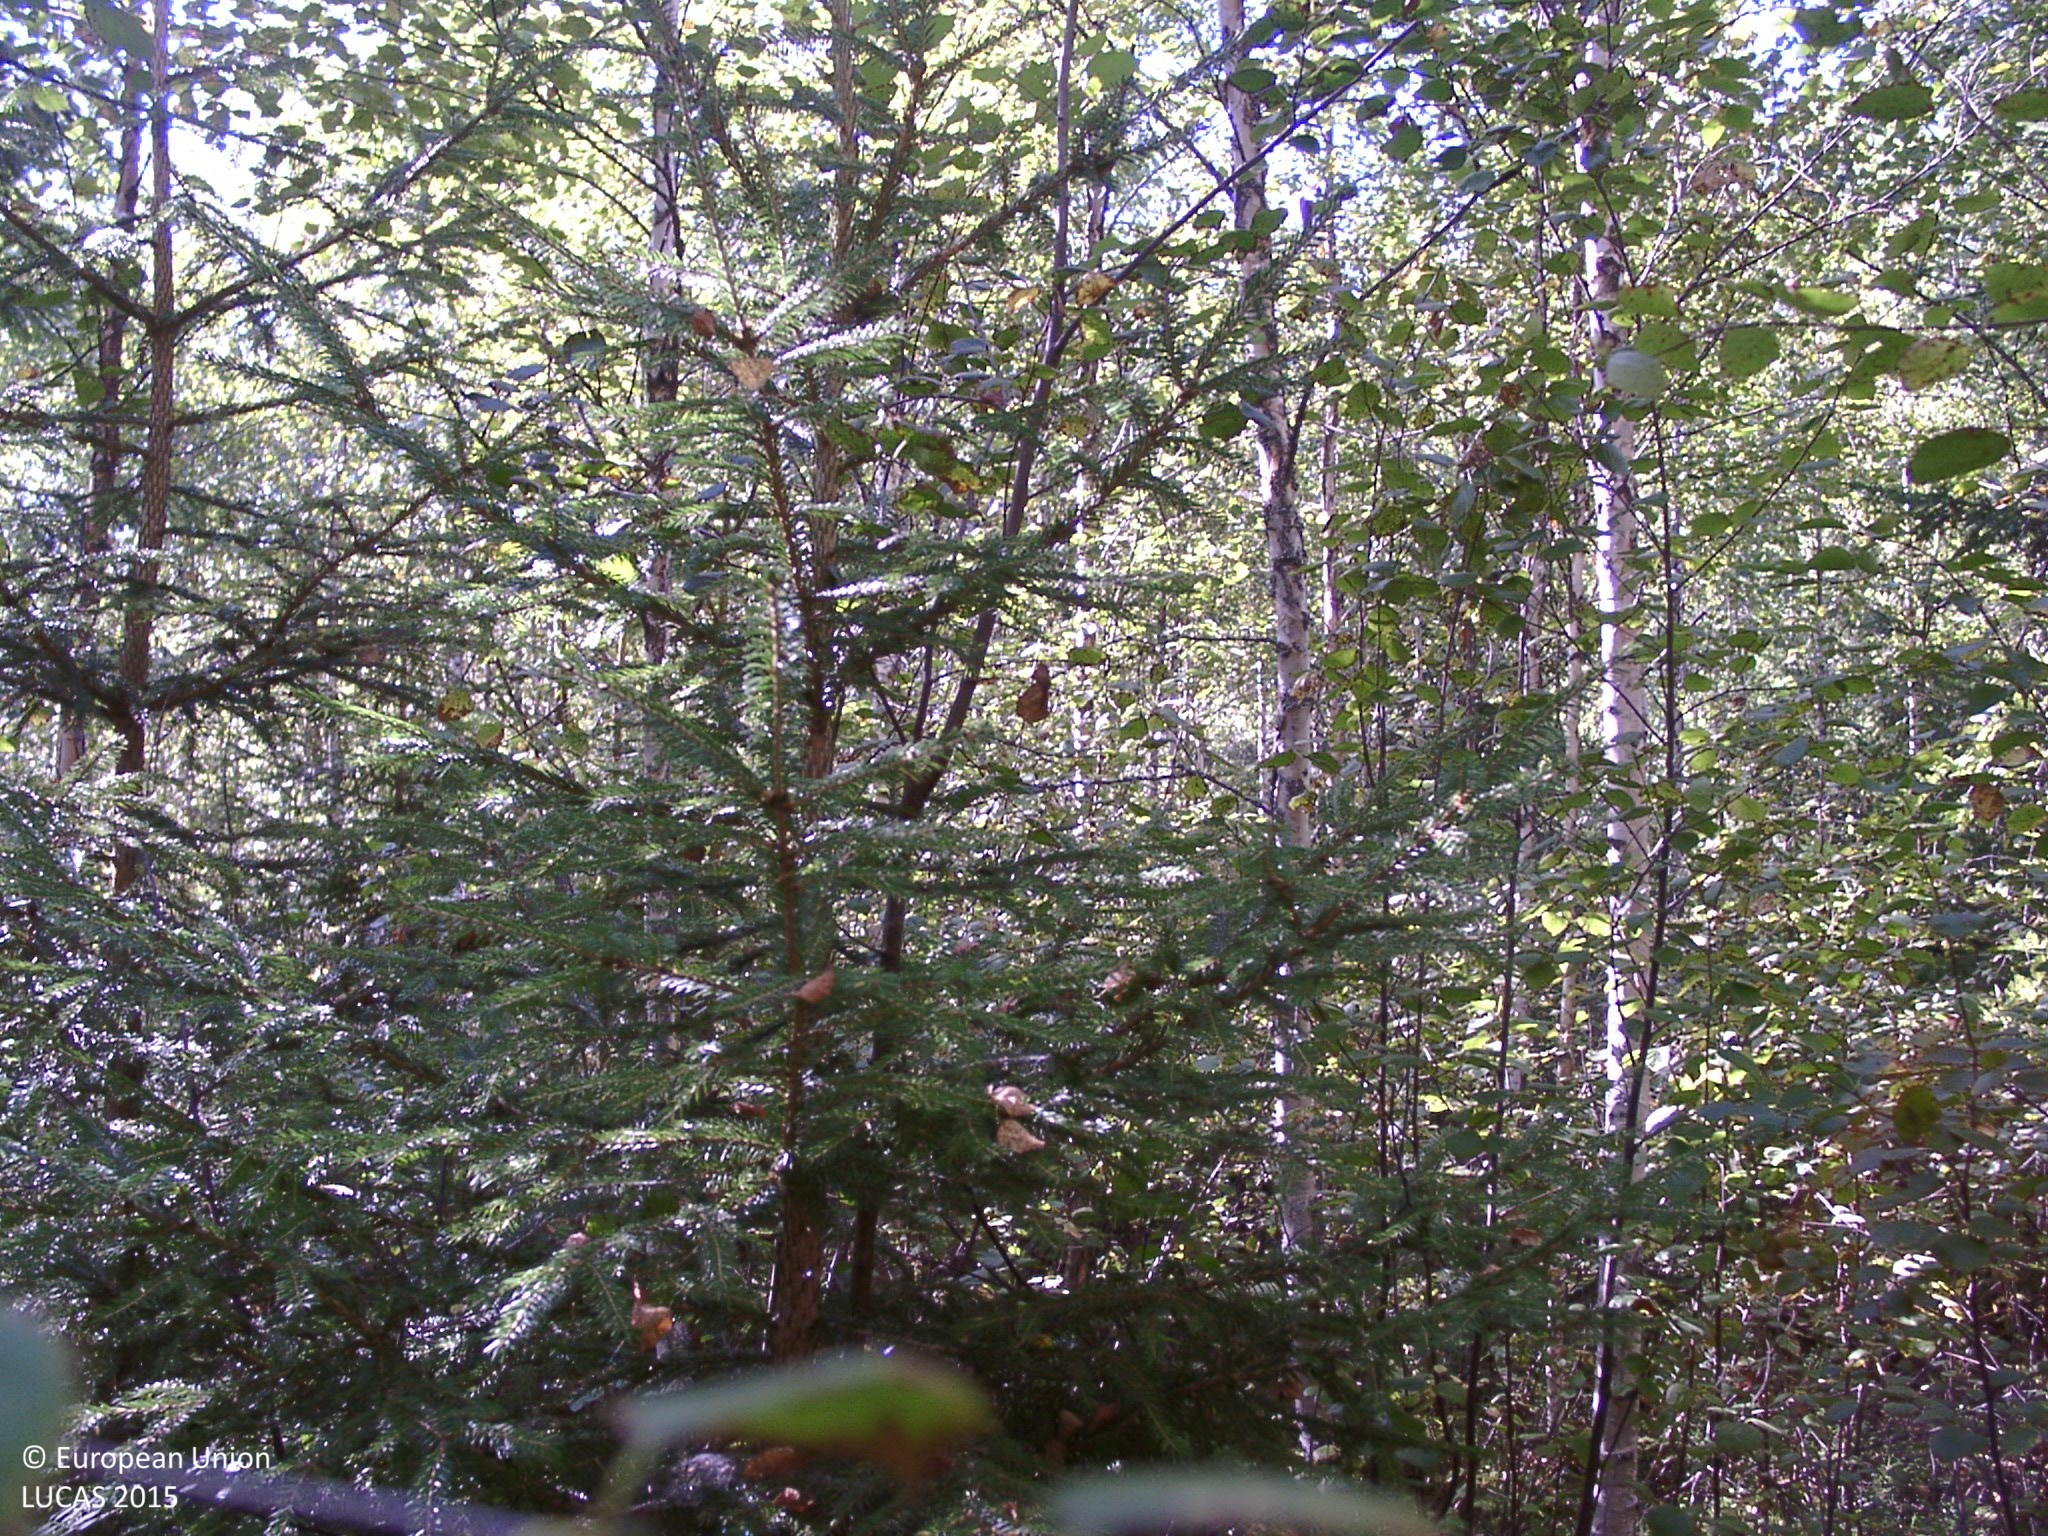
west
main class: Woodland
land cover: Broadleaved woodland
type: boreal forest
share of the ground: > 75 %
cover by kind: broadleaved forest trees 65 %, coniferous forest trees 20 %, shrubs 10 %, unconsolidated bare surface 5 %
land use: Forestry
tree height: > 5 m
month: August
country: FI
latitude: 62.4092
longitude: 25.3403
